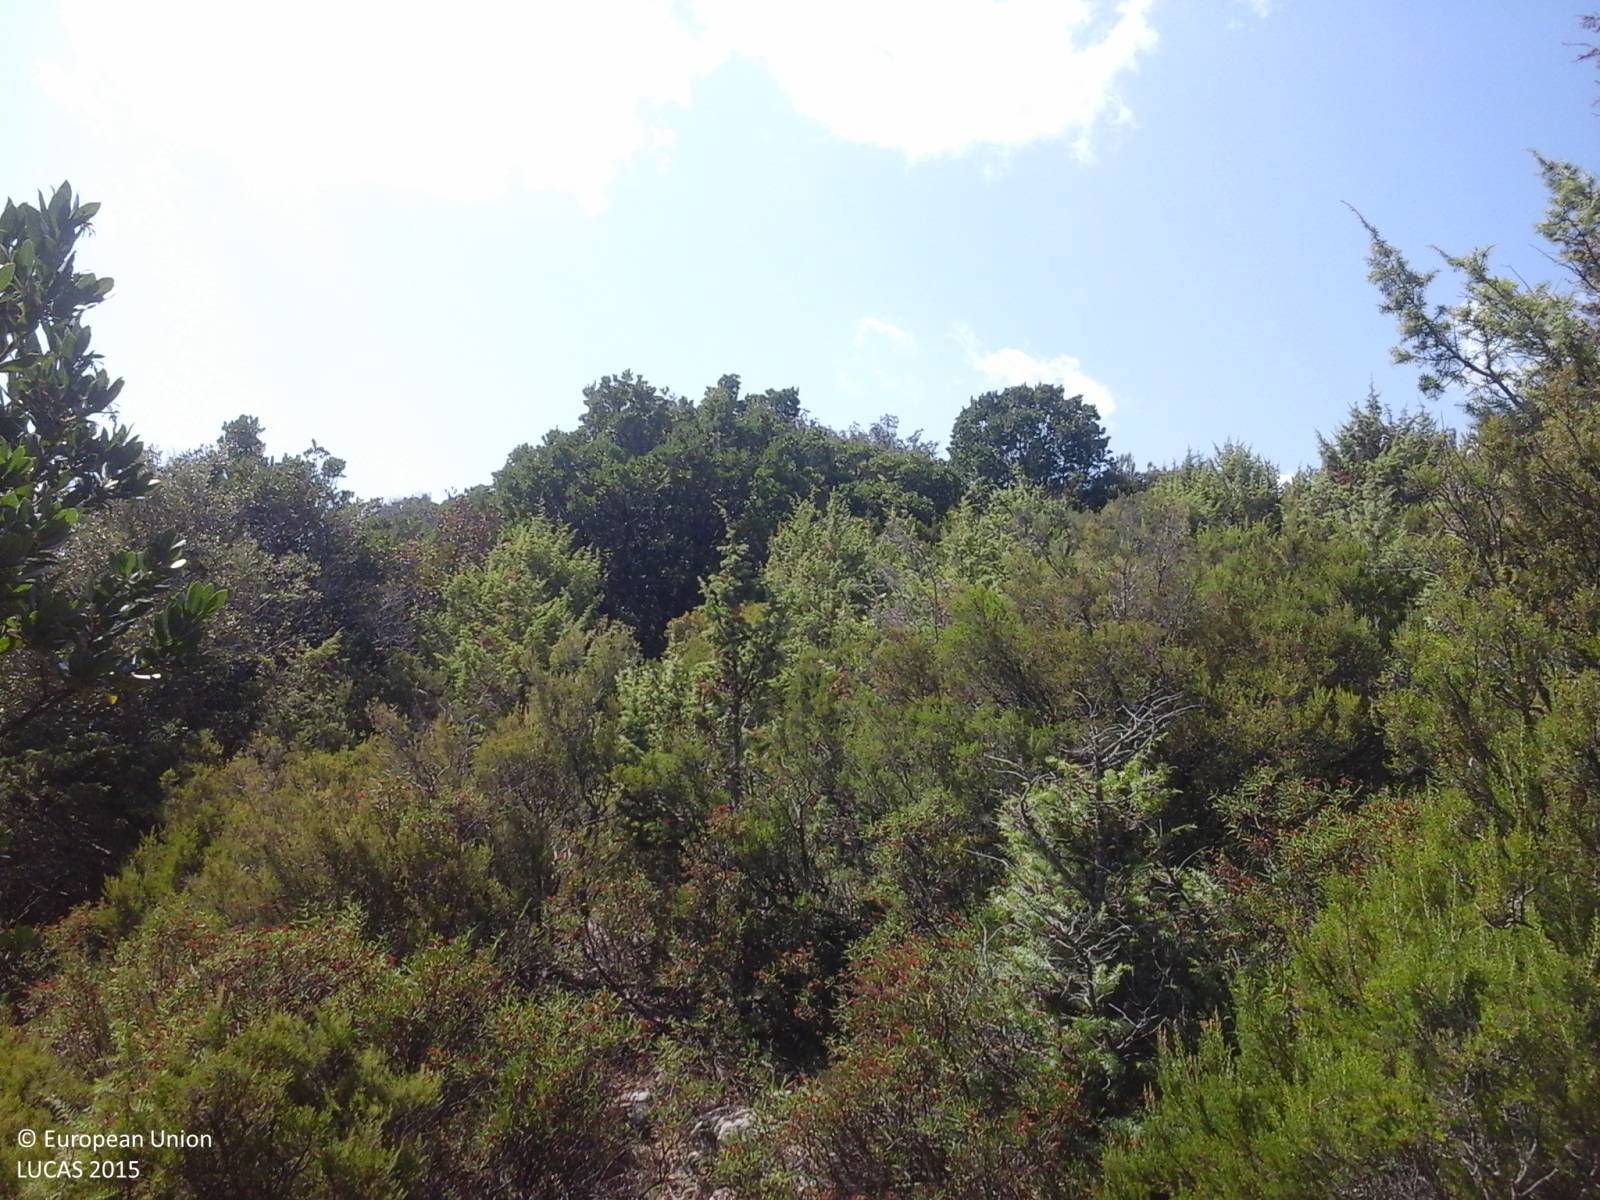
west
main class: Shrubland
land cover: Shrubland without tree cover
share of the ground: > 75 %
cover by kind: shrubs 90 %, herbaceous plants 10 %
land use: Semi-natural and natural areas not in use
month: September
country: IT
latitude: 40.0304
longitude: 9.4522
